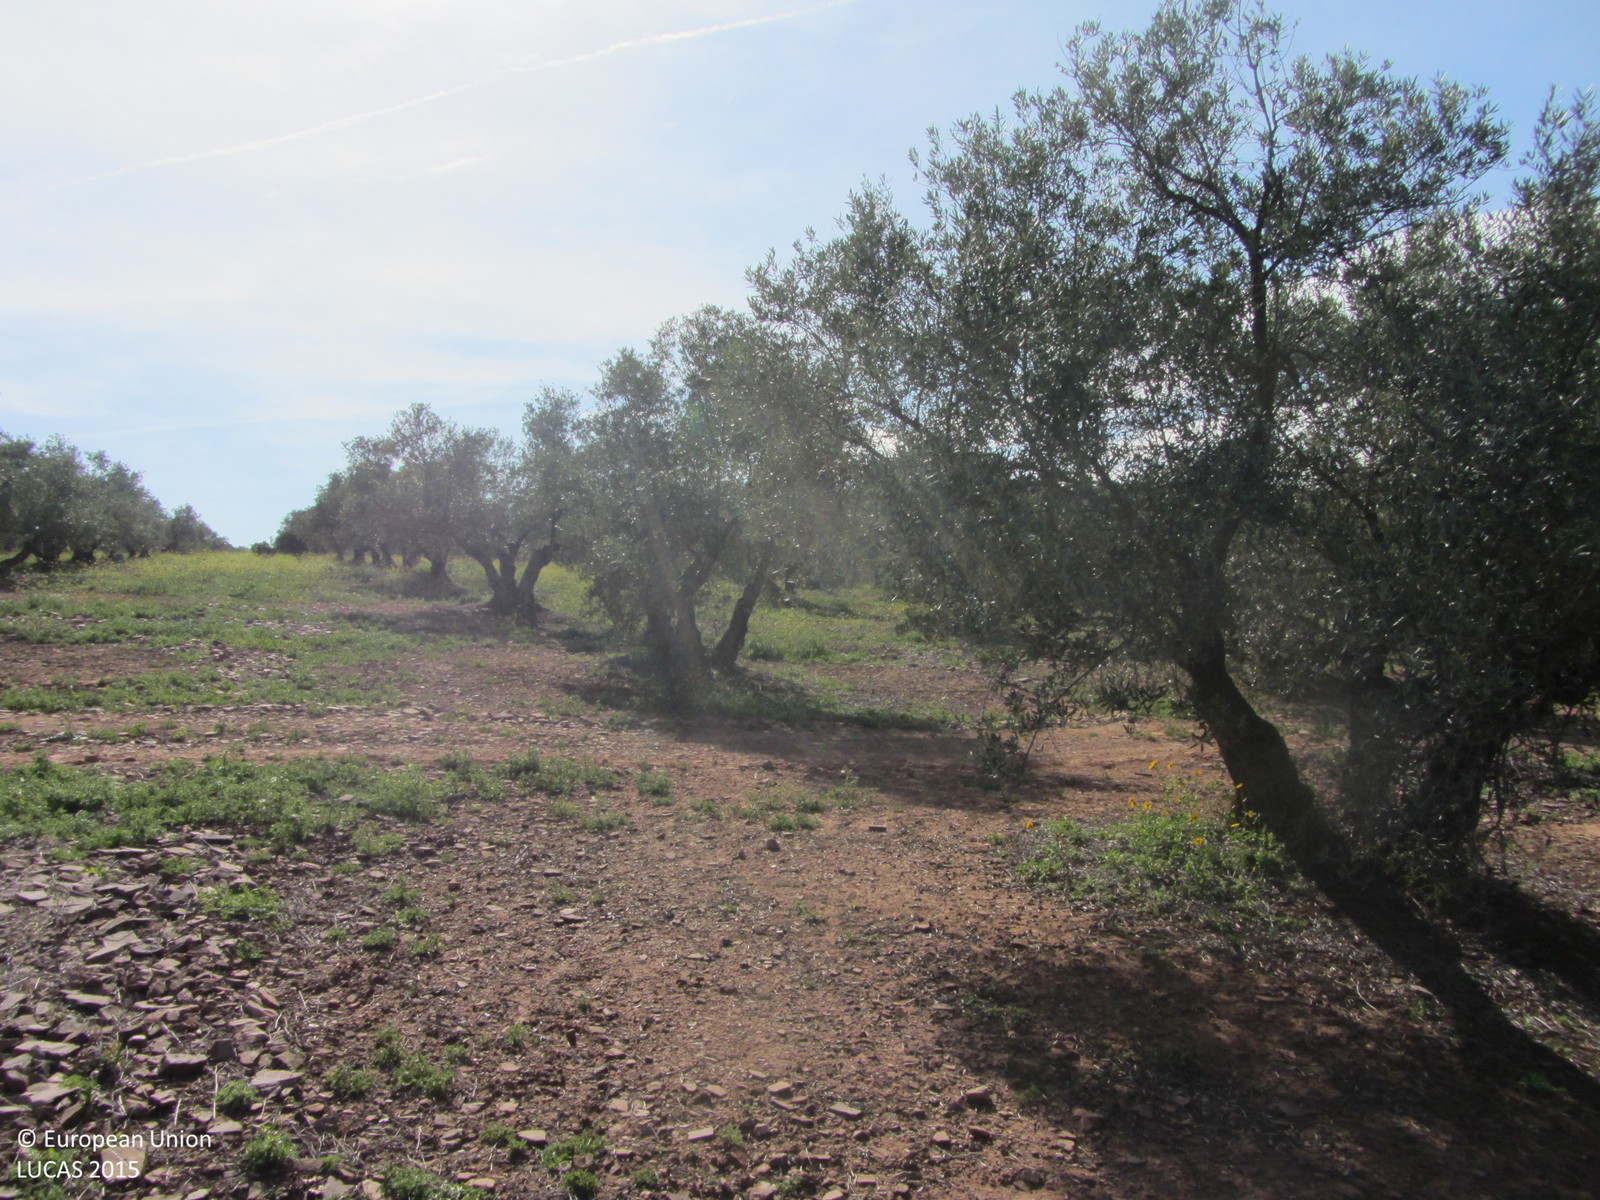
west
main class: Cropland
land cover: Olive groves
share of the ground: 25 - 50 %
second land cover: Spontaneously vegetated surfaces
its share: 25 - 50 %
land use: Agriculture (excluding fallow land and kitchen gardens)
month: May
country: ES
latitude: 38.3885
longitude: -3.0193
